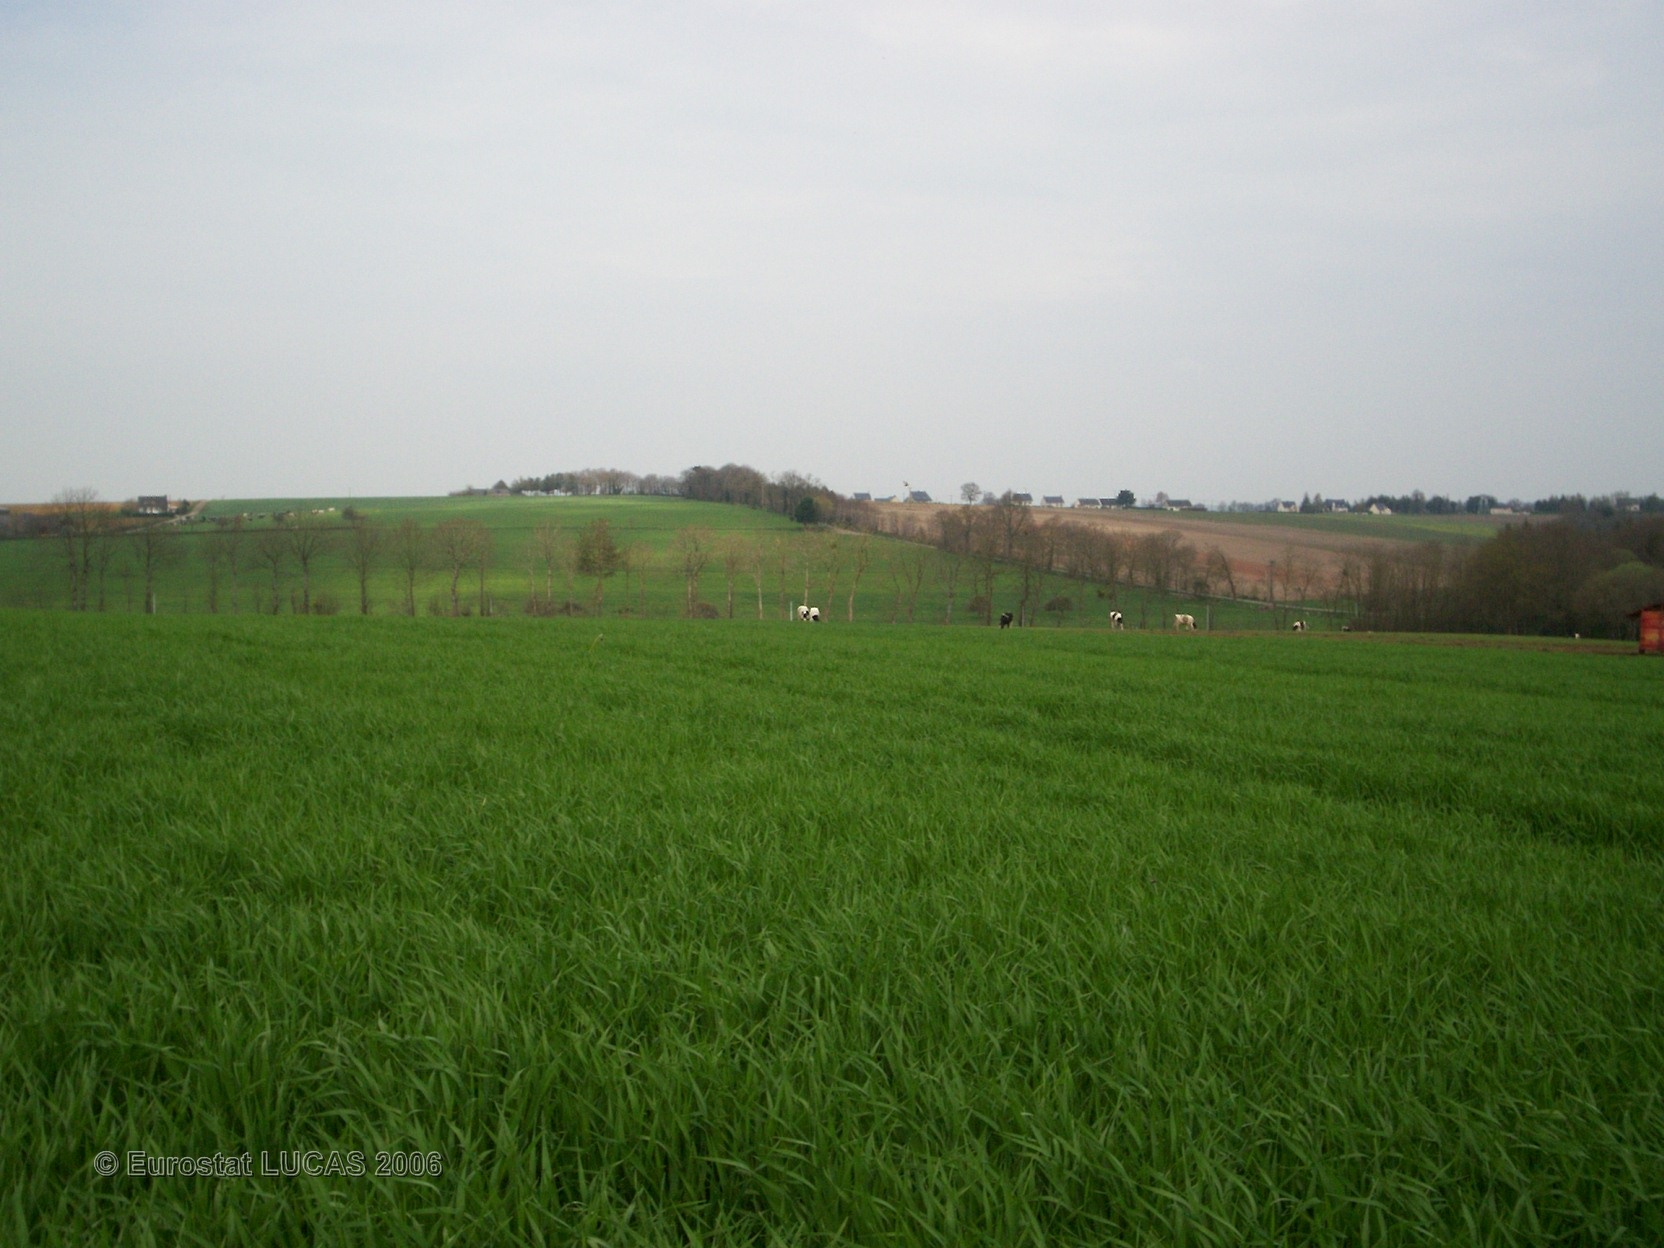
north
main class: Cropland
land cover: Barley
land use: Agriculture (excluding fallow land and kitchen gardens)
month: April
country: FR
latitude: 48.0600
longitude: -2.7712
